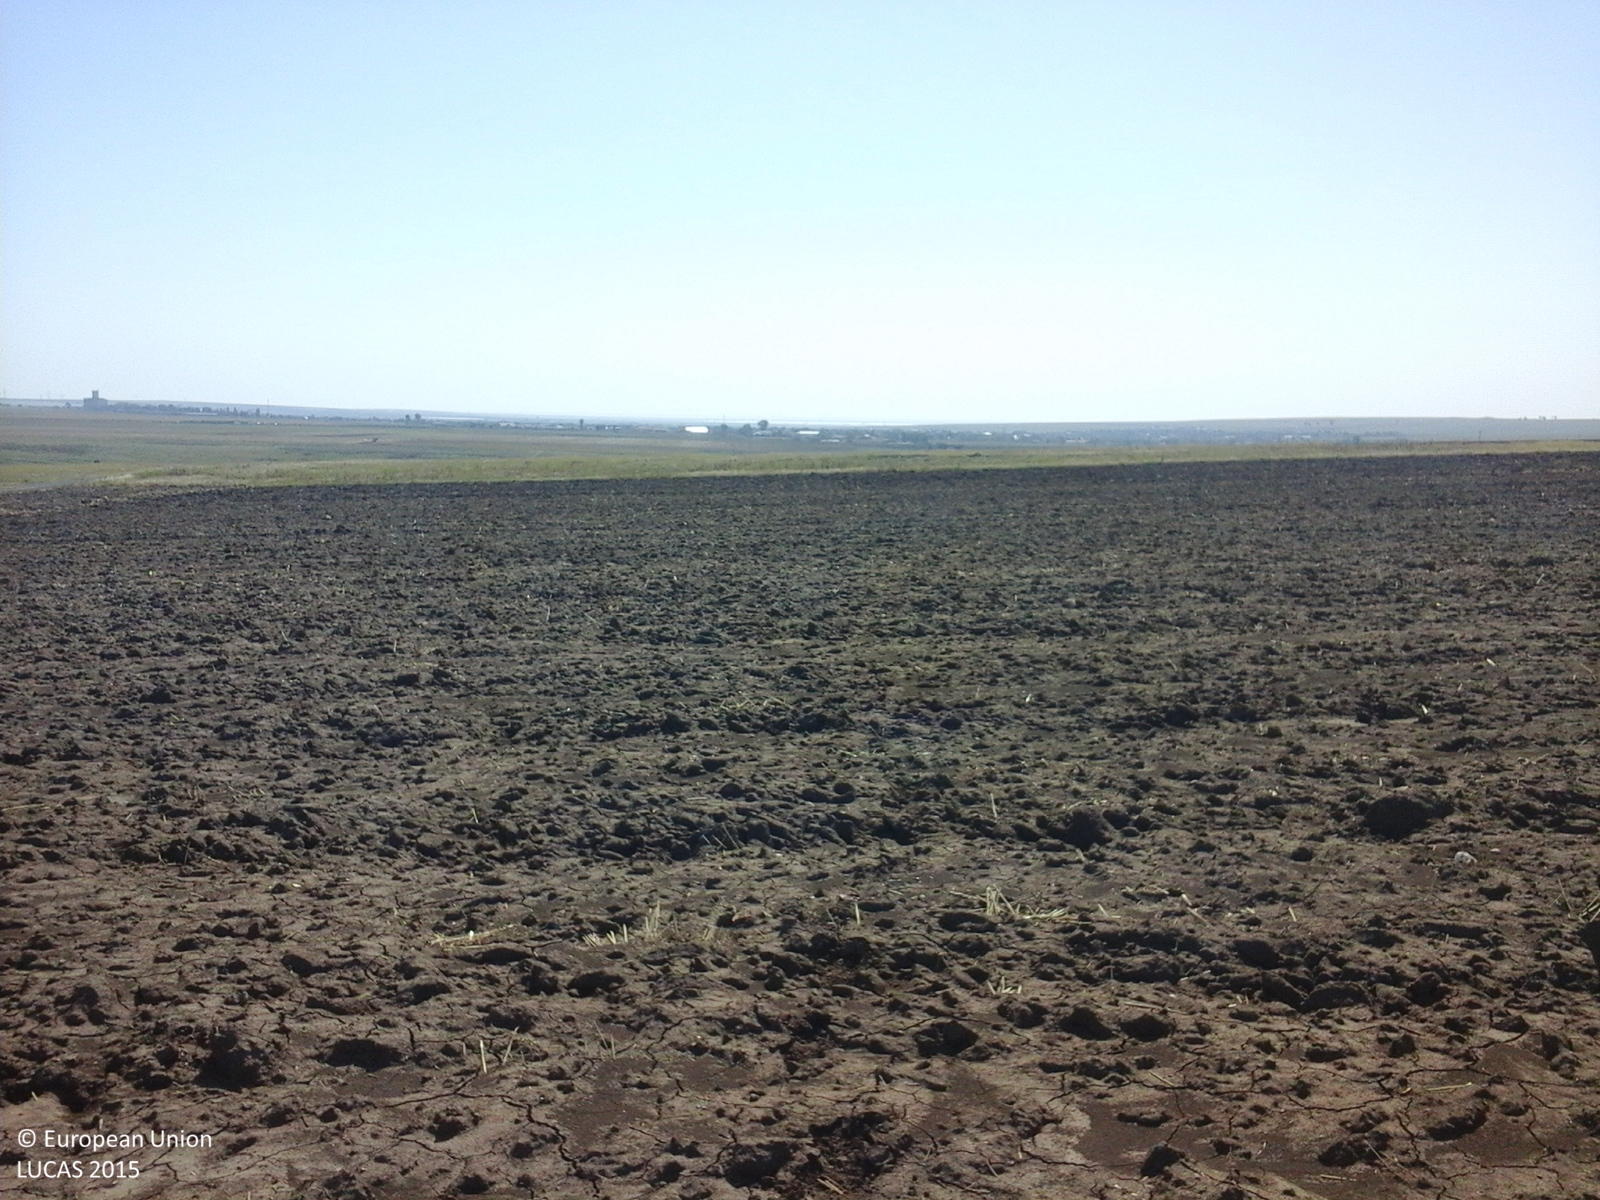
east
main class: Cropland
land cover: Common wheat
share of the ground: < 10 %
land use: Agriculture (excluding fallow land and kitchen gardens)
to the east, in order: Common wheat
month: August
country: RO
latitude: 44.5674
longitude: 28.5211
